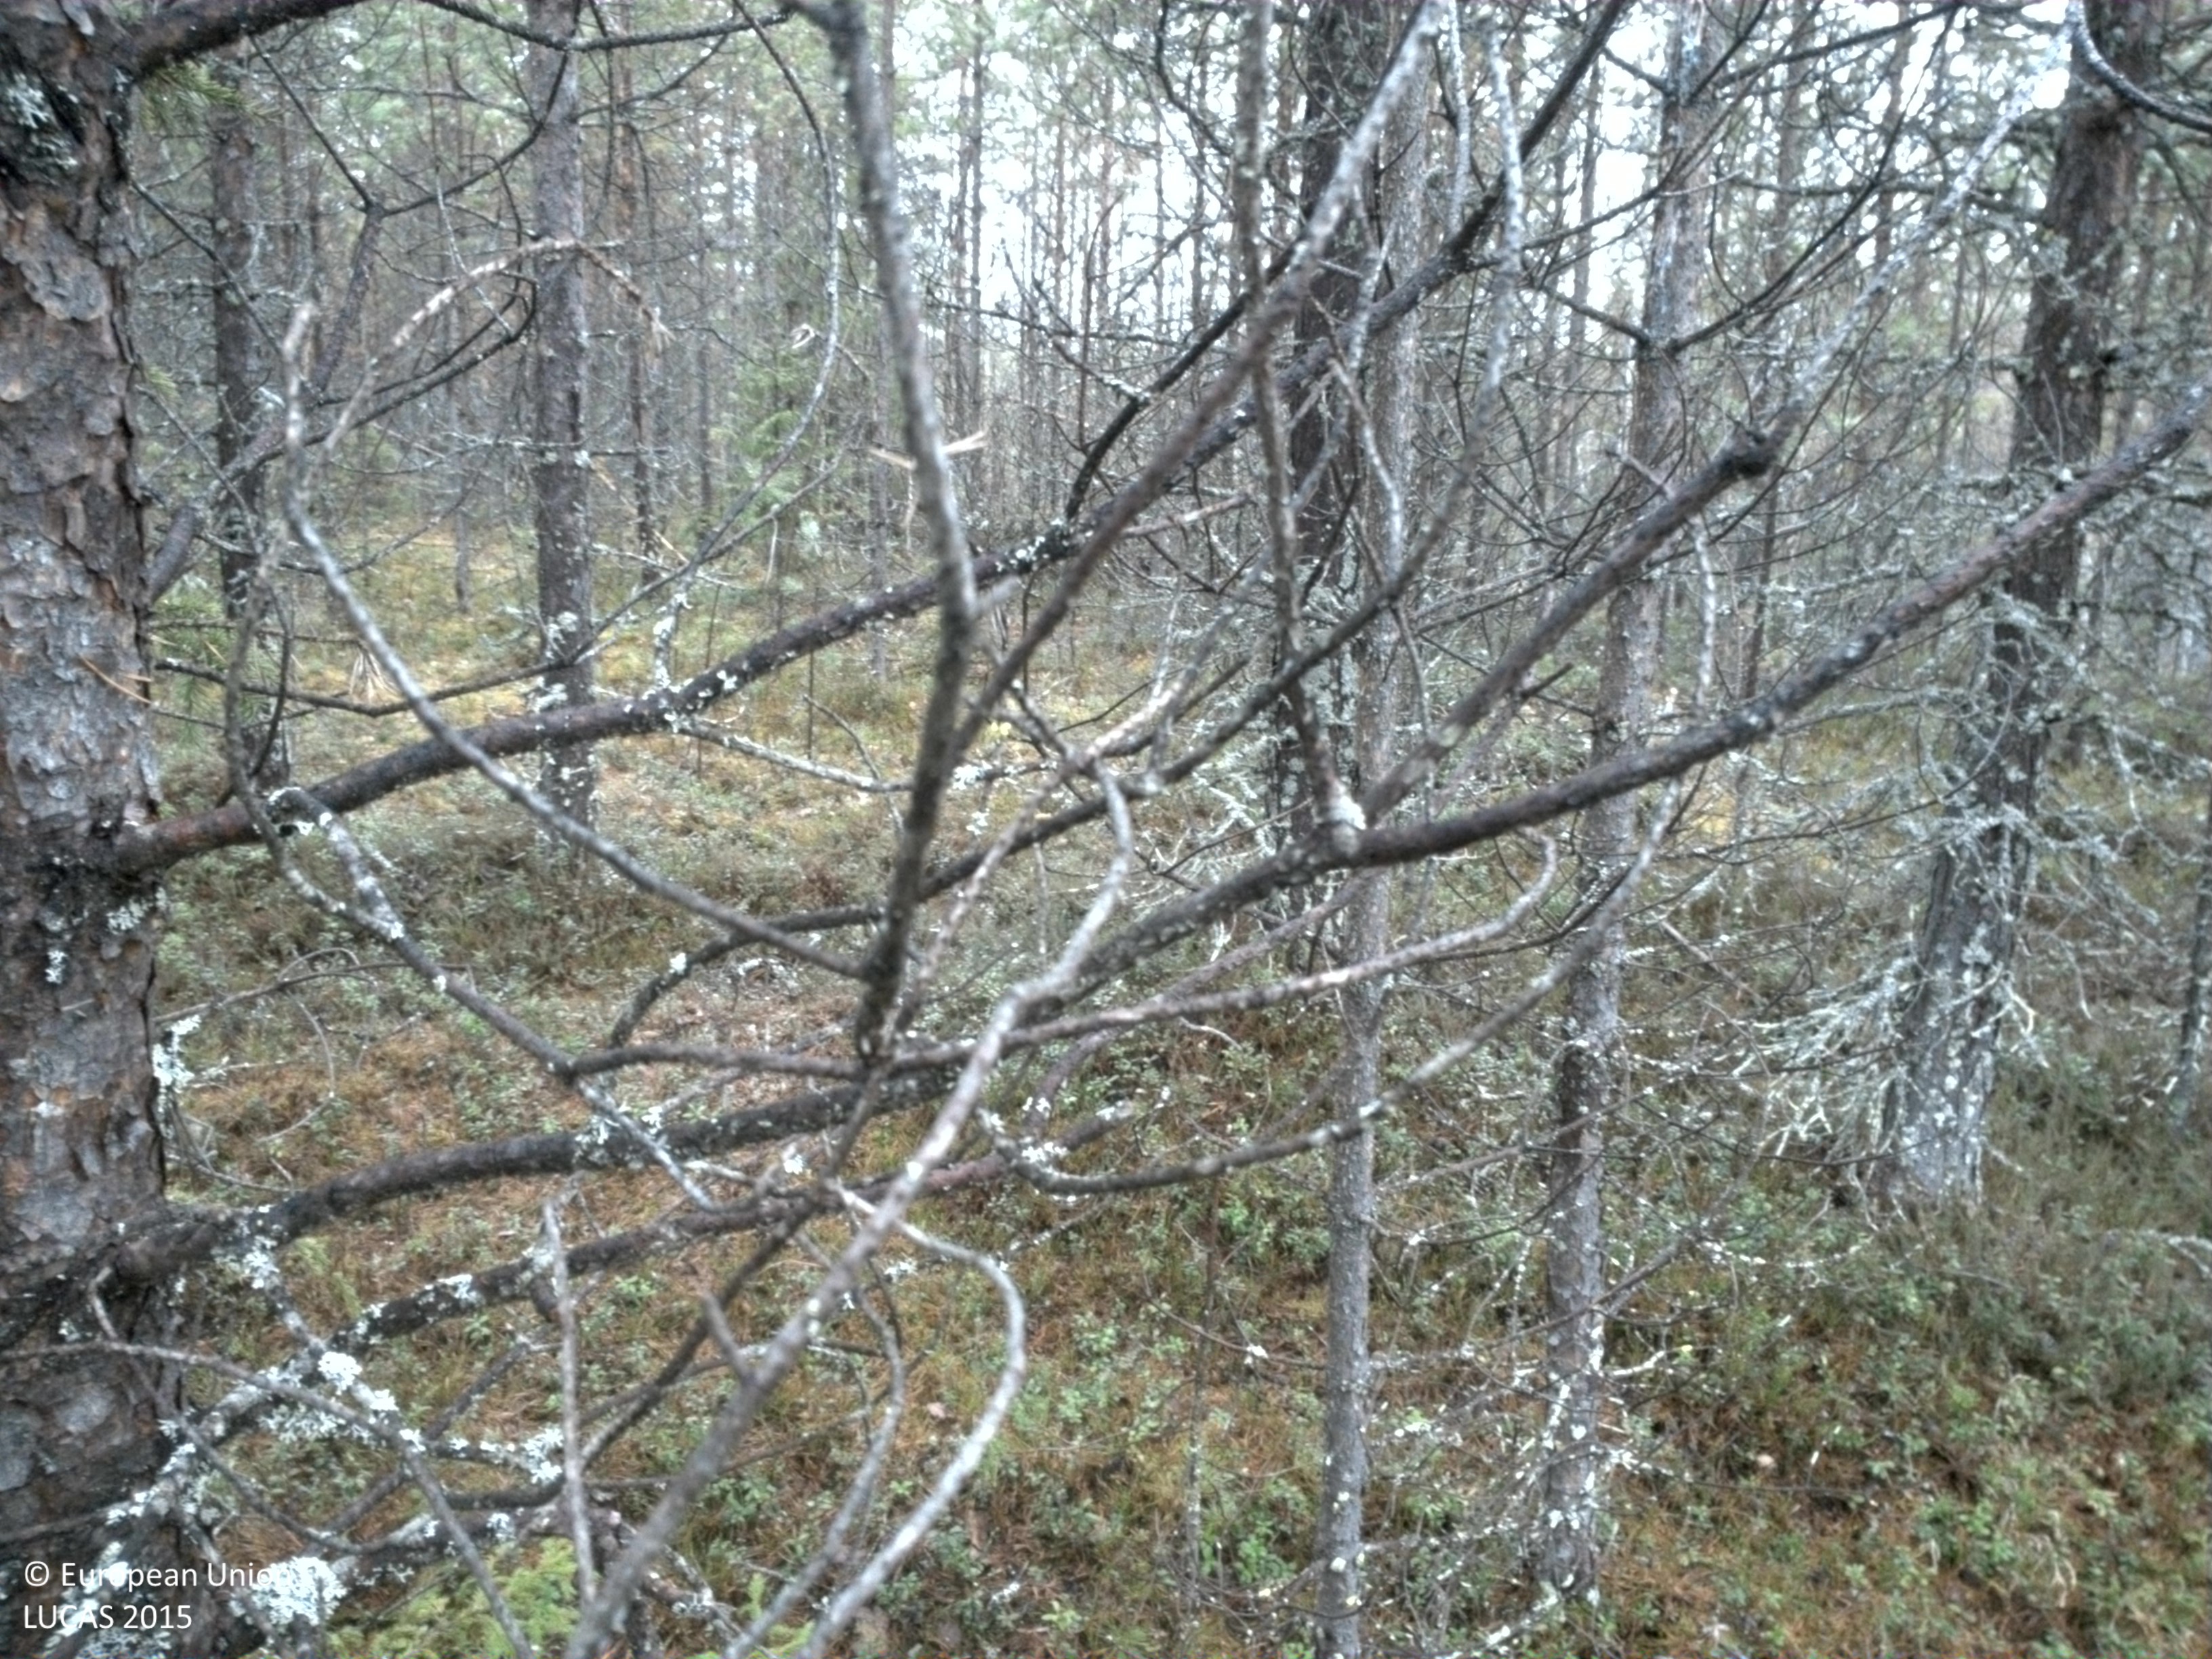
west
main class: Woodland
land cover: Pine dominated coniferous woodland
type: boreal forest
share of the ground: 50 - 75 %
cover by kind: coniferous forest trees 60 %, lichens and mosses 25 %, shrubs 15 %
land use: Forestry
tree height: > 5 m
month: May
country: SE
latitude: 65.9244
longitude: 22.9236
